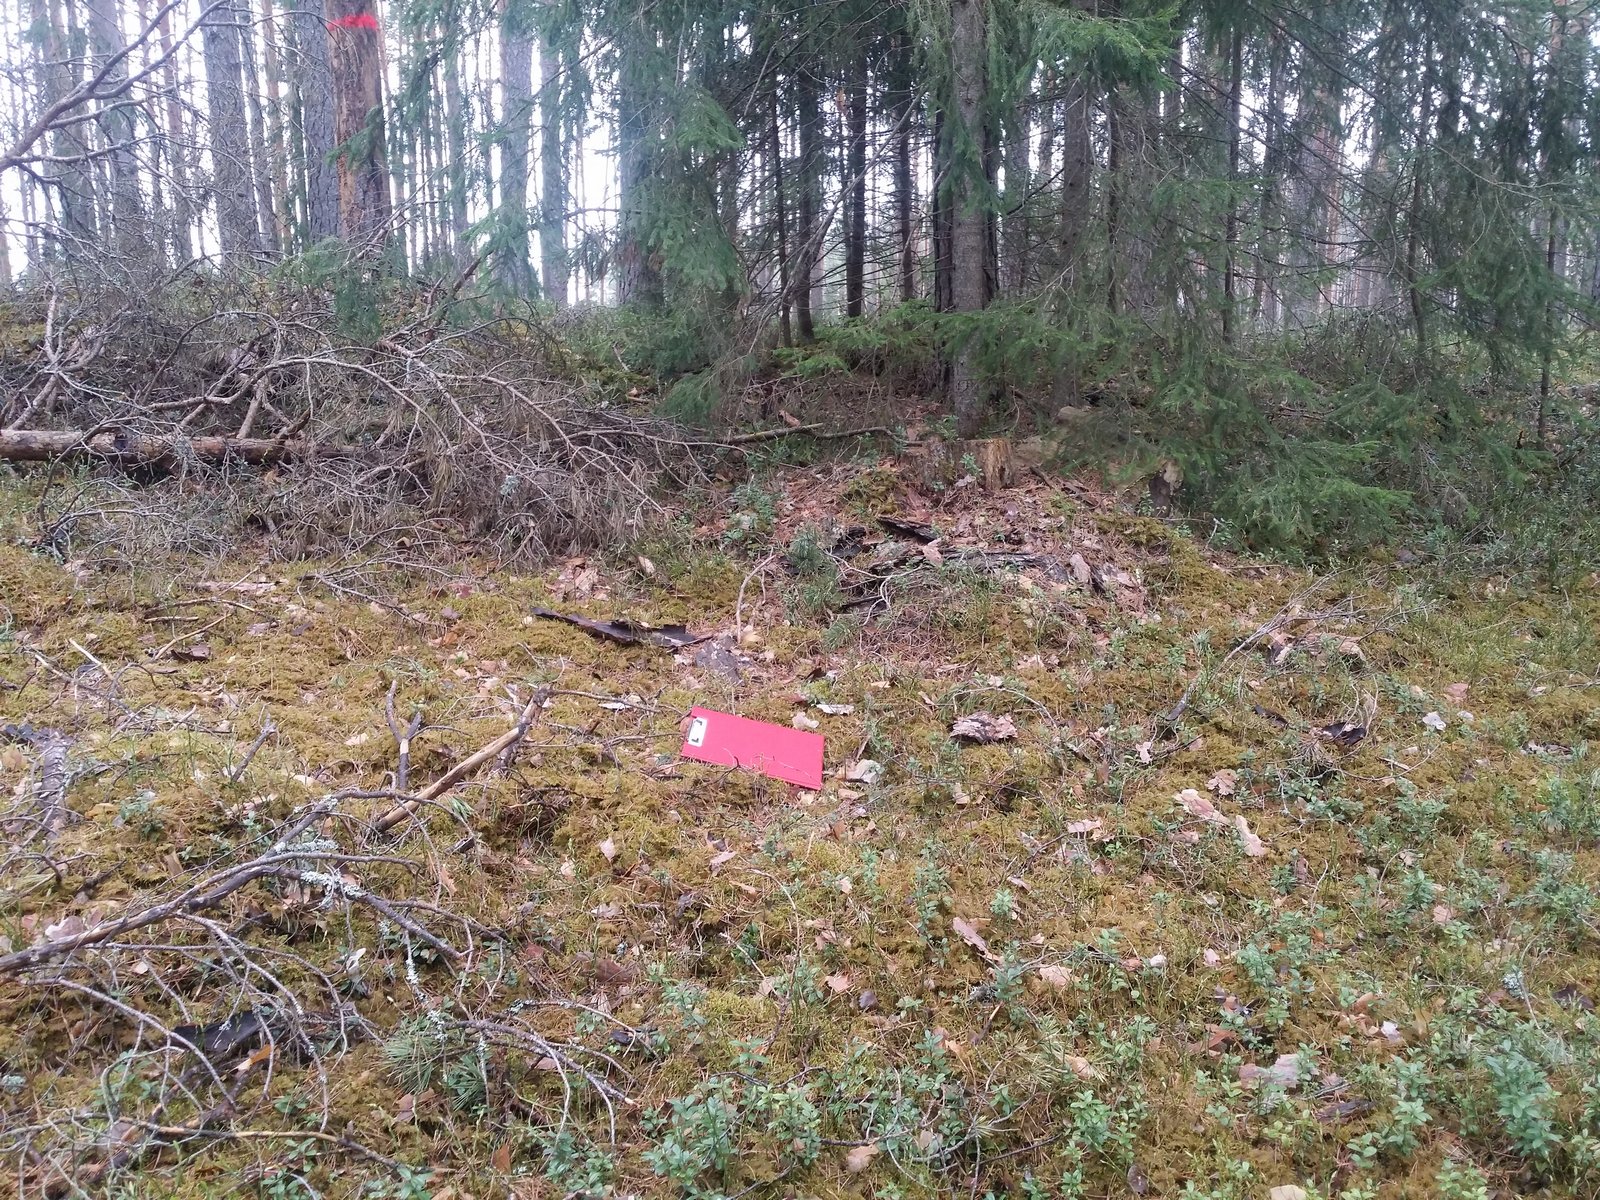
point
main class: Woodland
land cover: Other coniferous woodland
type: hemiboreal forest and nemoral coniferous forest and mixed broadleaved-coniferous forest
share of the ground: > 75 %
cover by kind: coniferous forest trees 90 %, lichens and mosses 10 %
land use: Forestry
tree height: > 5 m
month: May
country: LV
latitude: 57.4483
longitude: 26.0436
